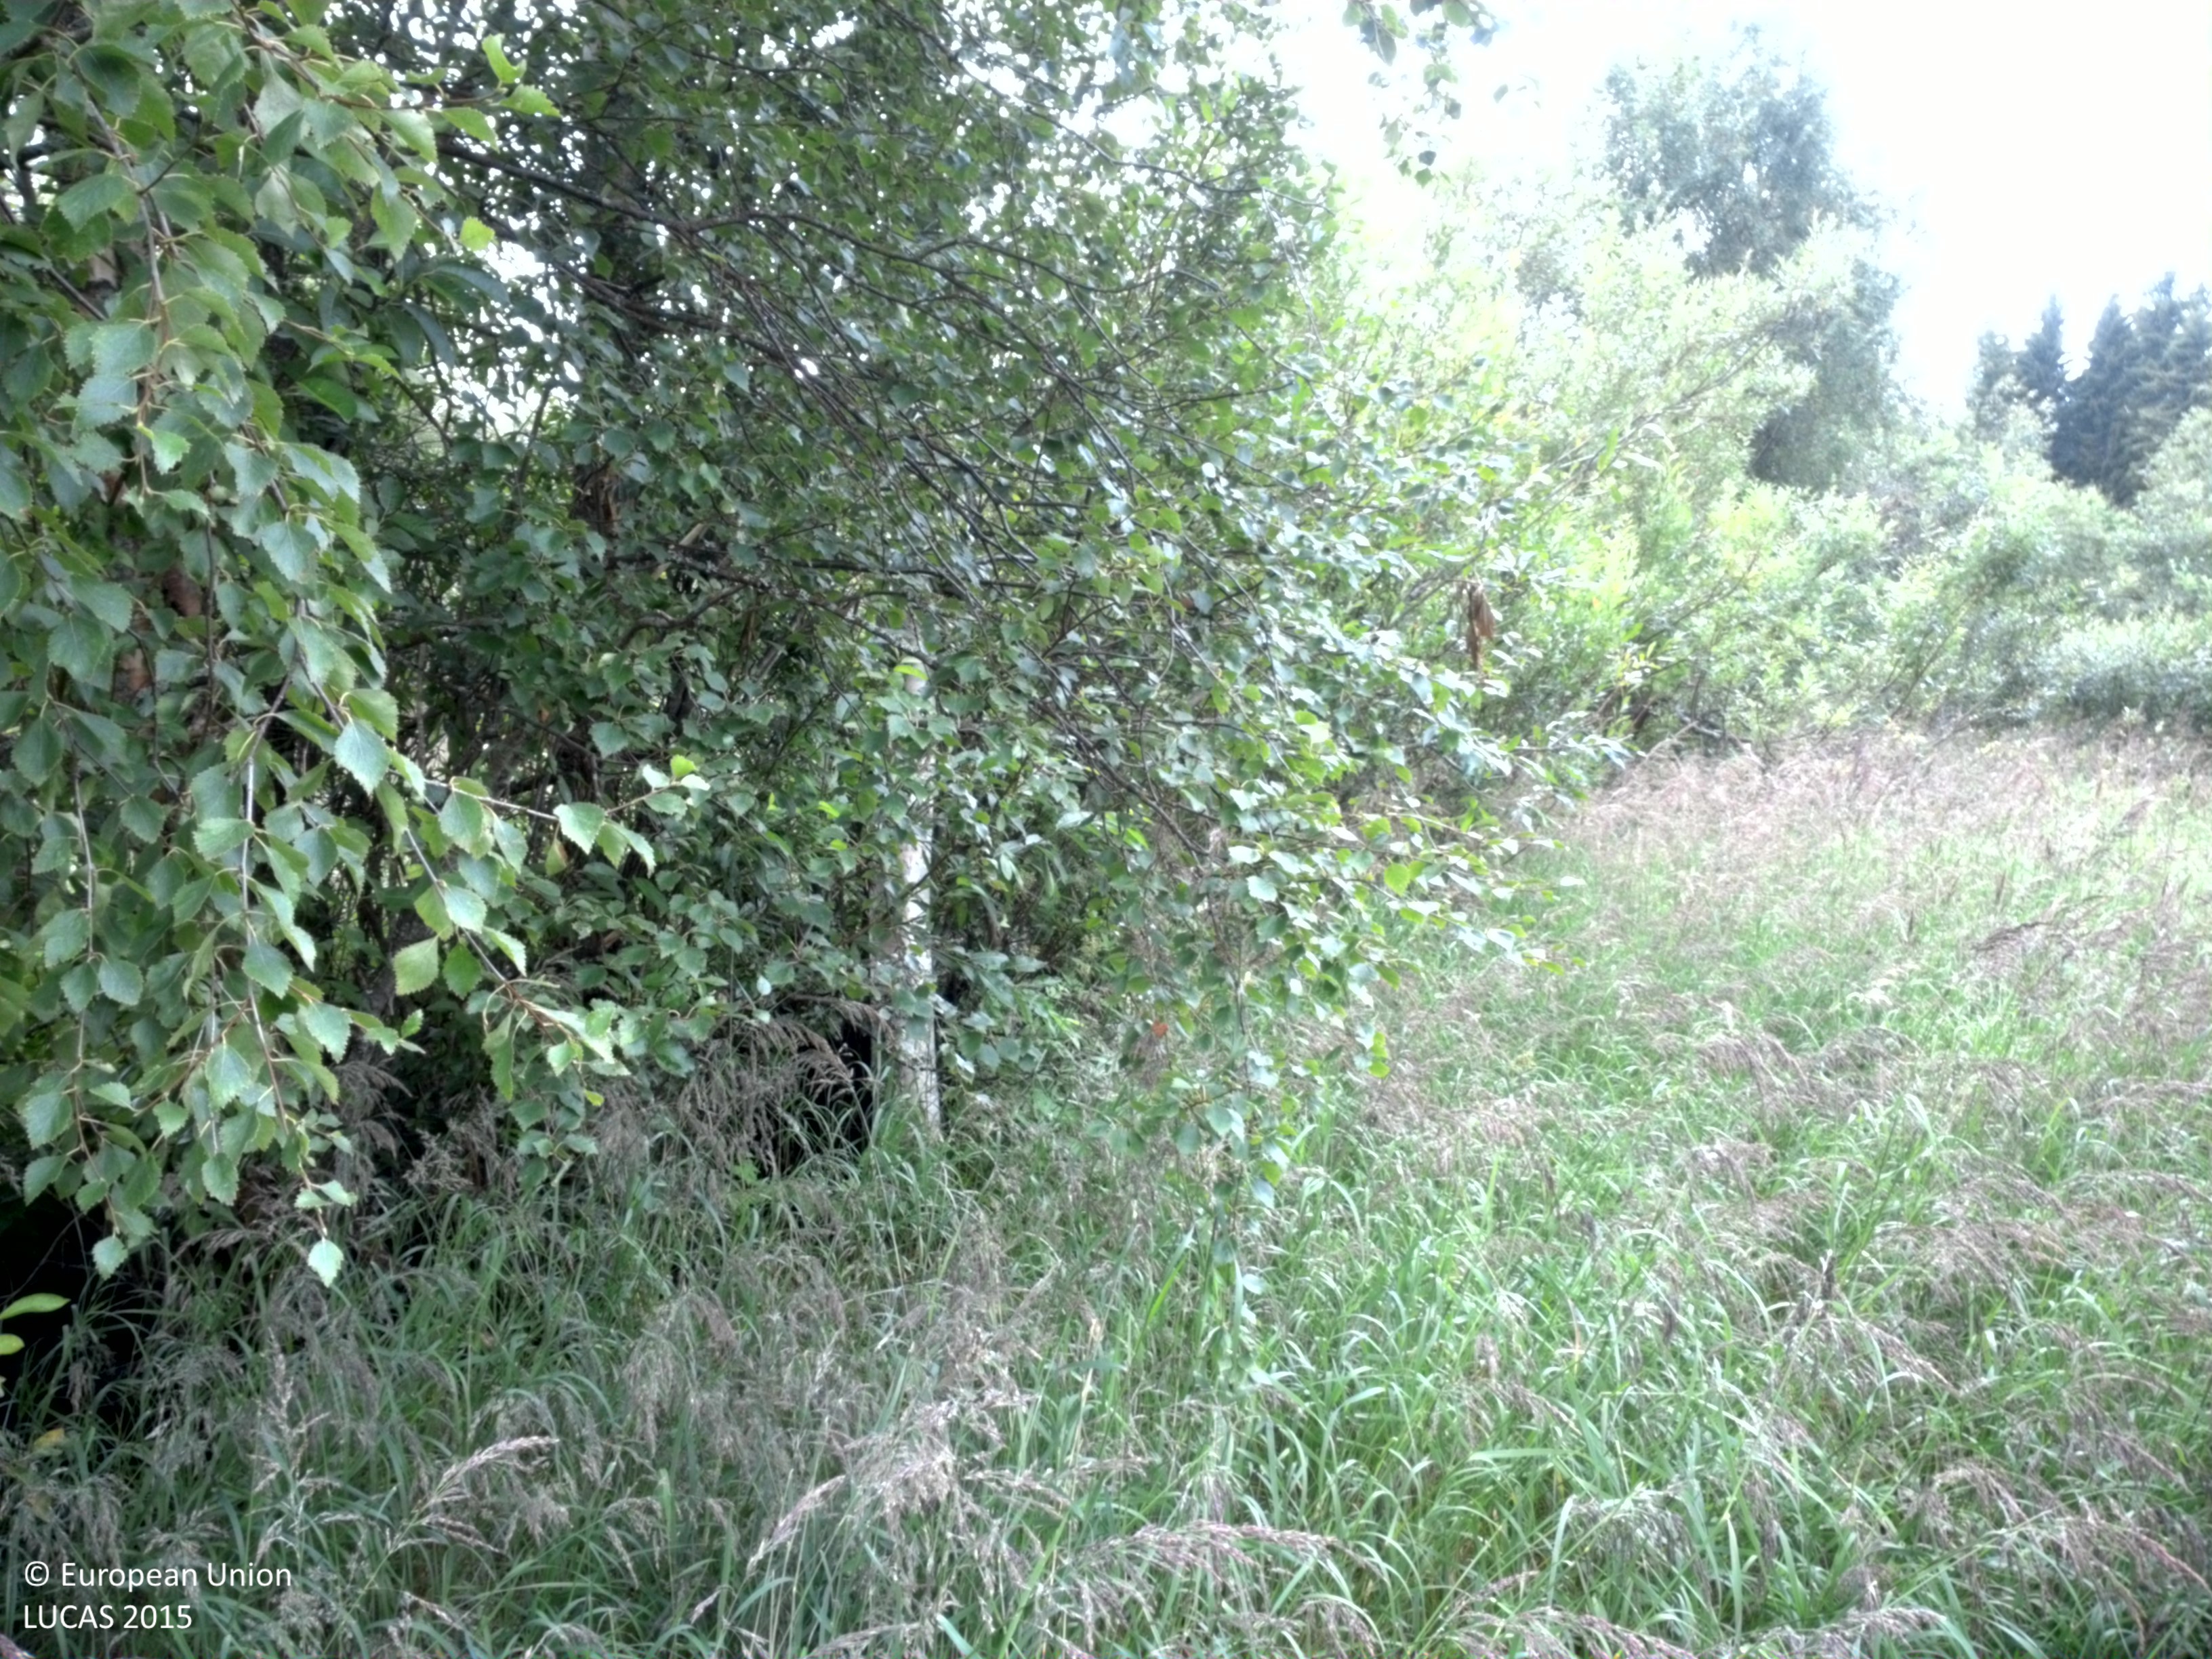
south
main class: Grassland
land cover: Grassland with sparse tree/shrub cover
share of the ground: > 75 %
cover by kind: herbaceous plants 95 %, broadleaved forest trees 5 %
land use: Agriculture (excluding fallow land and kitchen gardens)
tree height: > 5 m
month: August
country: SE
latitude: 64.6413
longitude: 20.9235
